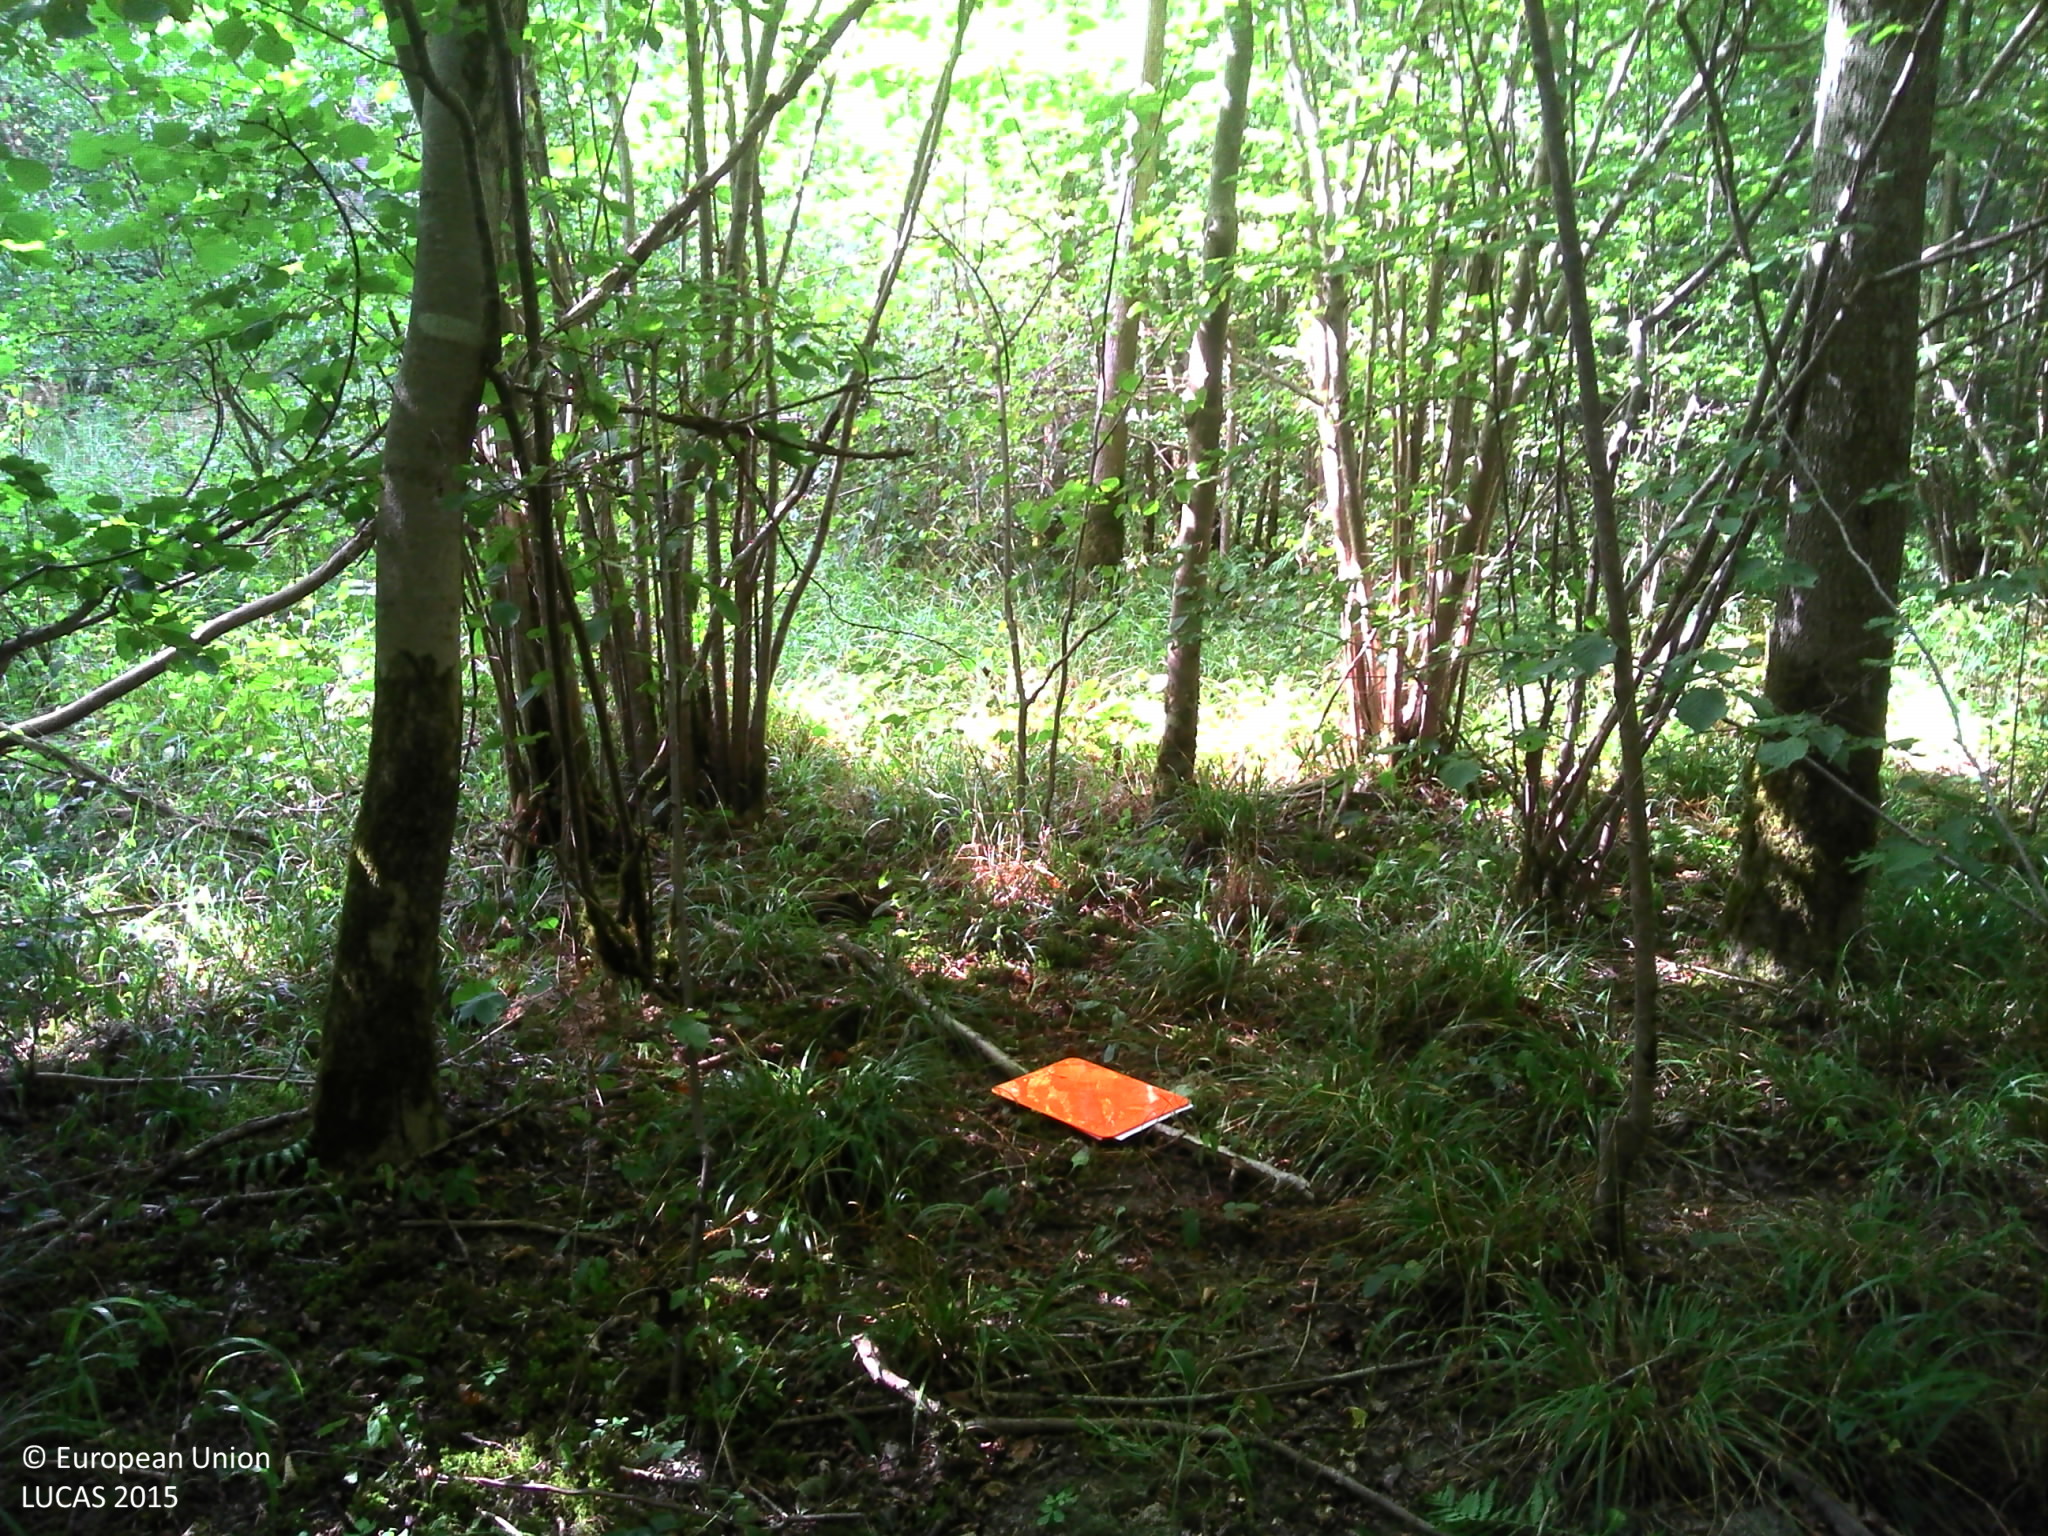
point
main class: Woodland
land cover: Broadleaved woodland
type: mesophytic deciduous forest
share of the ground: > 75 %
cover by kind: broadleaved forest trees 50 %, herbaceous plants 15 %, lichens and mosses 15 %, unconsolidated bare surface 10 %
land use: Forestry
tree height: > 5 m
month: July
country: FR
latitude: 48.7769
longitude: 2.7097
